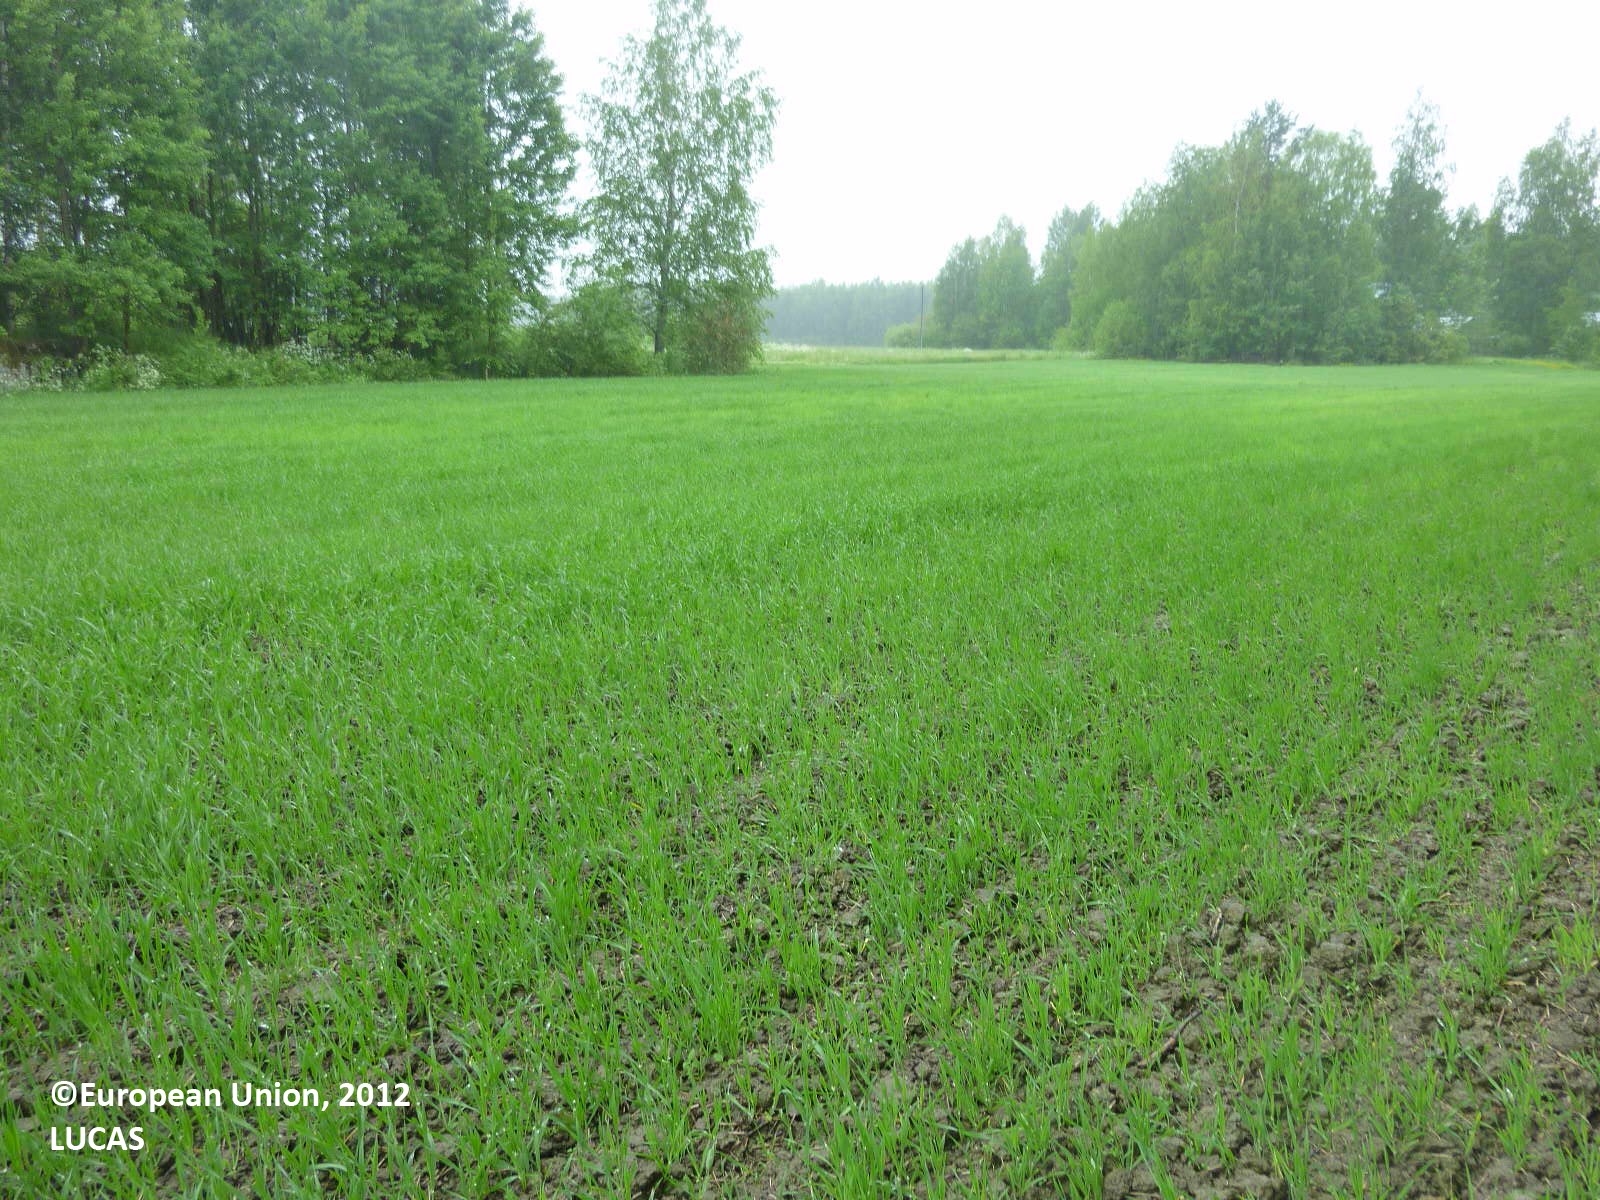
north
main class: Cropland
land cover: Barley
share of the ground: > 75 %
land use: Agriculture (excluding fallow land and kitchen gardens)
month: June
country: FI
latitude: 61.6094
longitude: 22.3335
